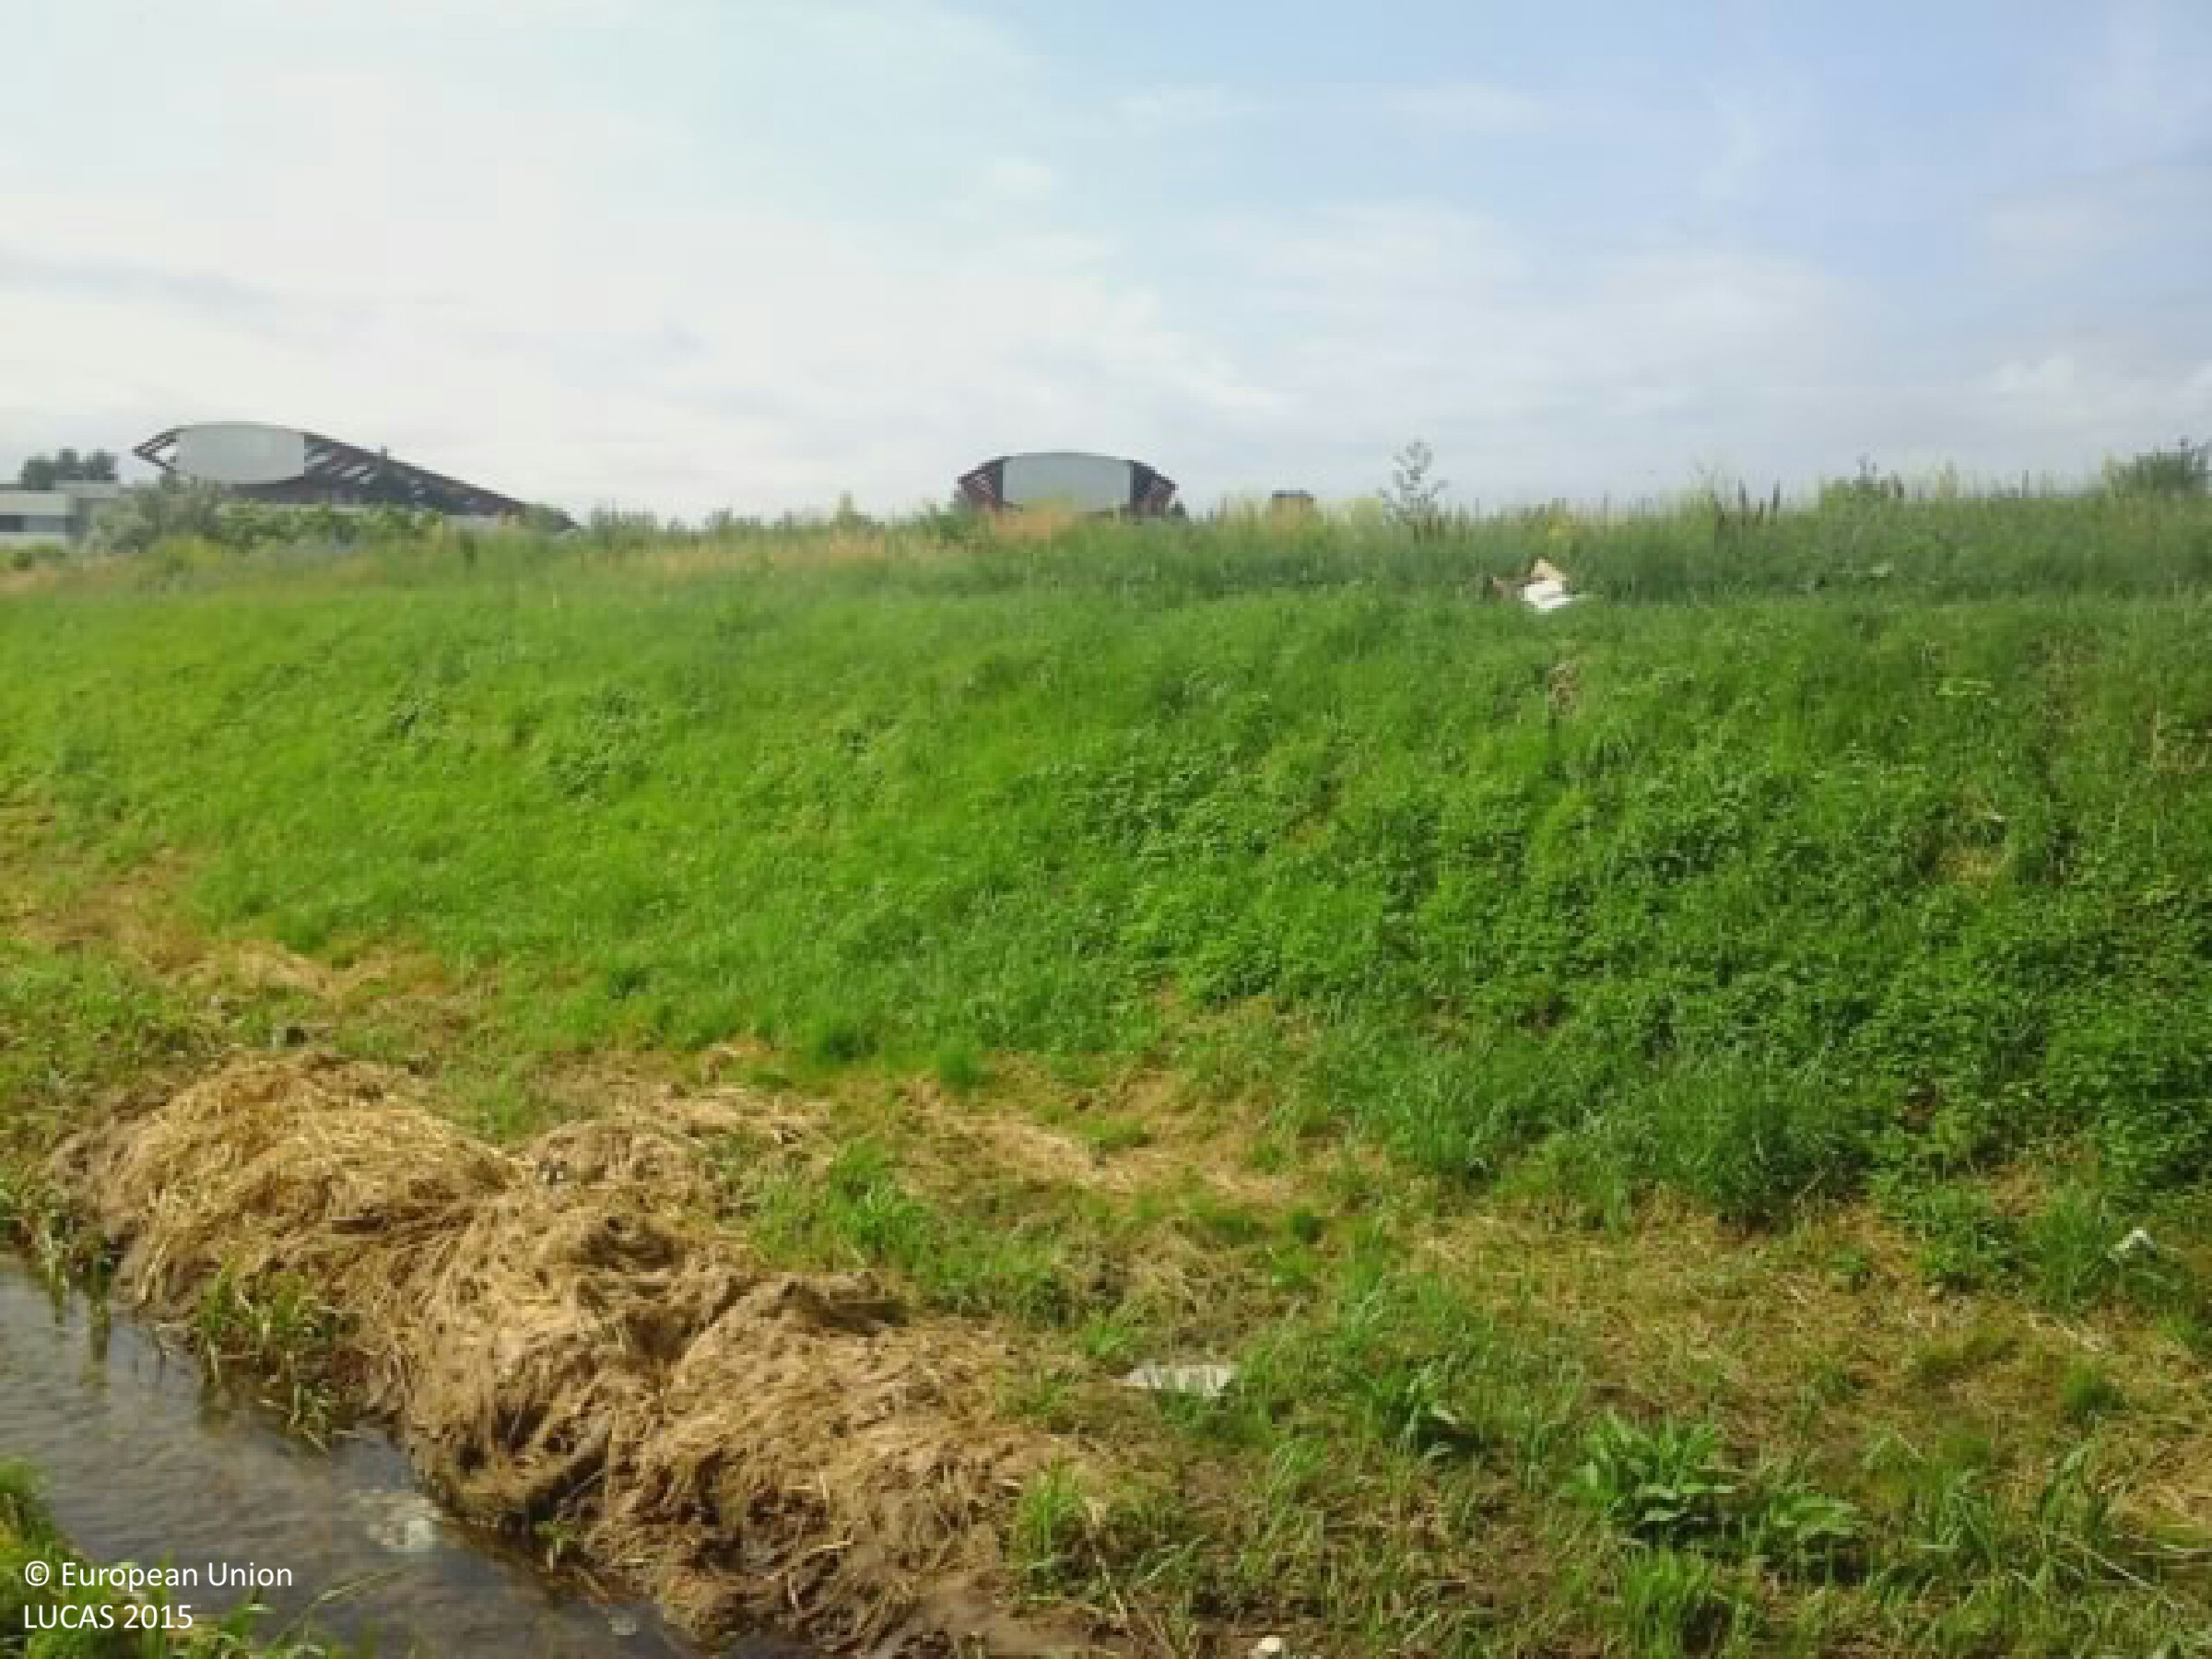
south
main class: Grassland
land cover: Grassland without tree/shrub cover
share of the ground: > 75 %
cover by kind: herbaceous plants 100 %
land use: Semi-natural and natural areas not in use
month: June
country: HU
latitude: 47.5528
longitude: 19.1480
